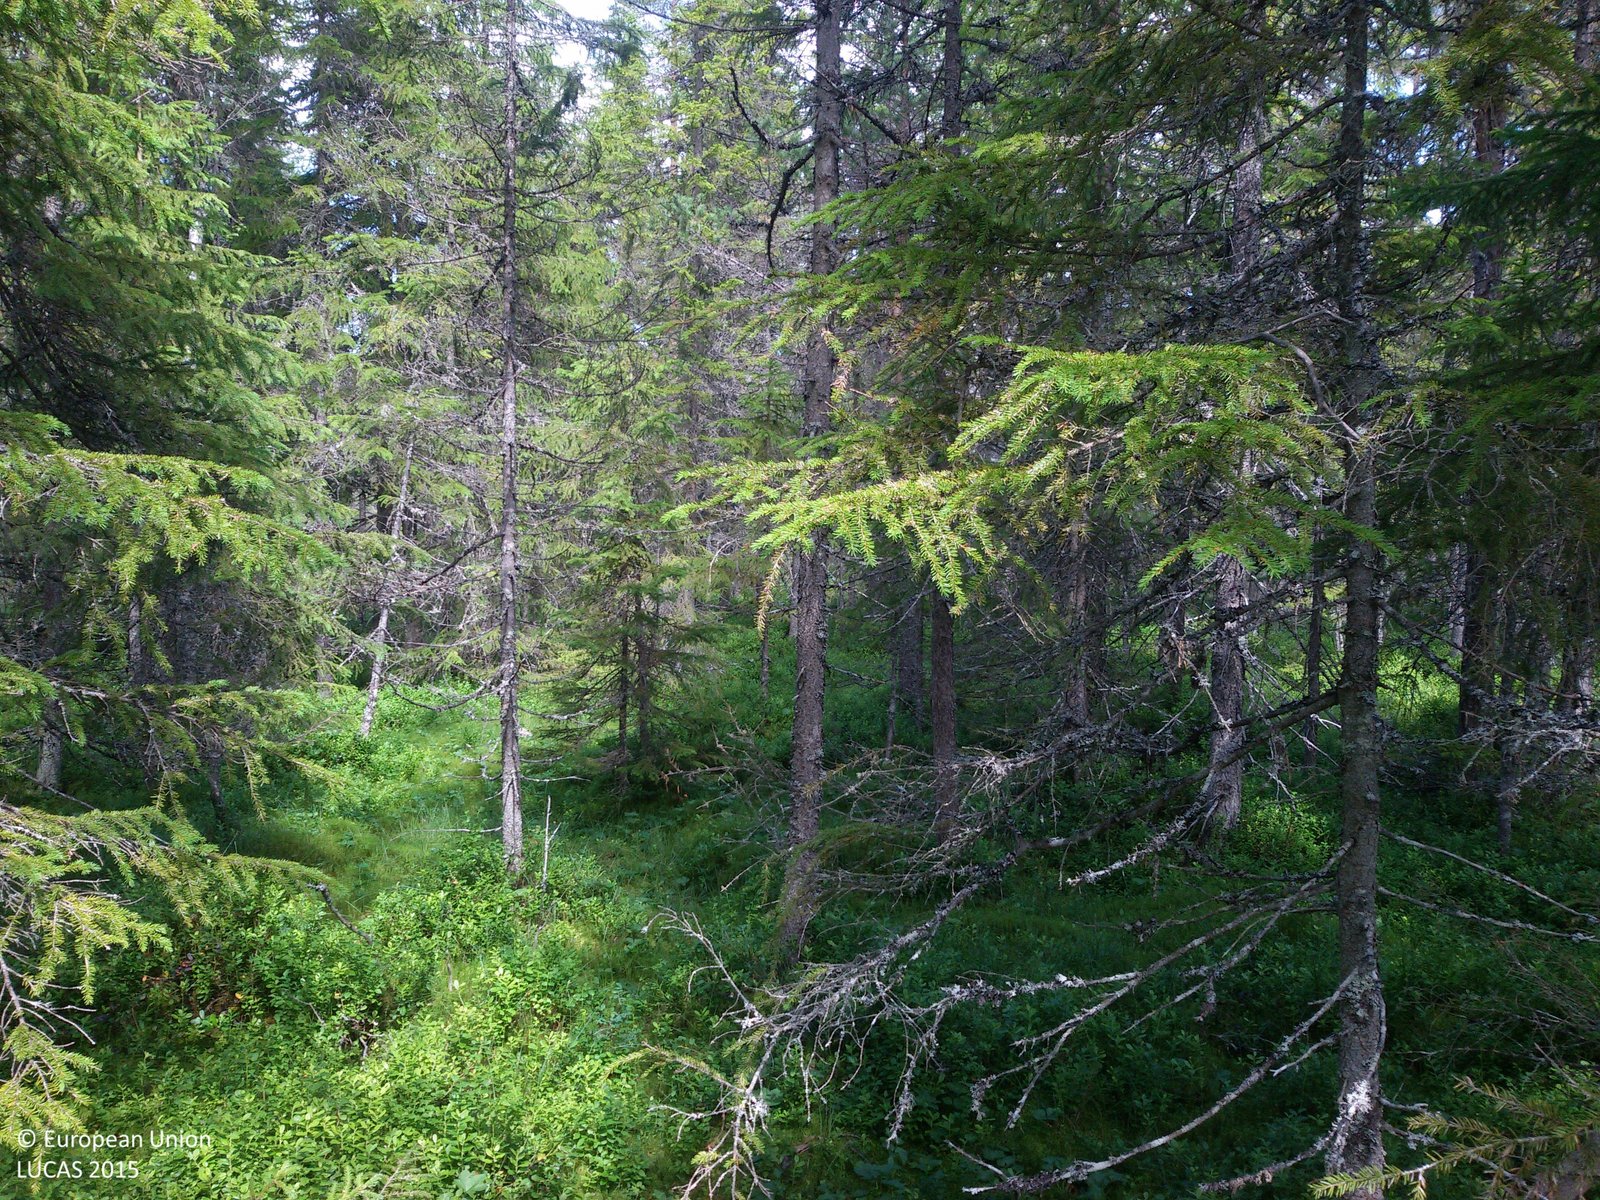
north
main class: Woodland
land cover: Spruce dominated coniferous woodland
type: boreal forest
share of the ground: 50 - 75 %
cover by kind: coniferous forest trees 65 %, shrubs 35 %
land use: Forestry
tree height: > 5 m
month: July
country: SE
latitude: 60.4316
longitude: 15.0930
